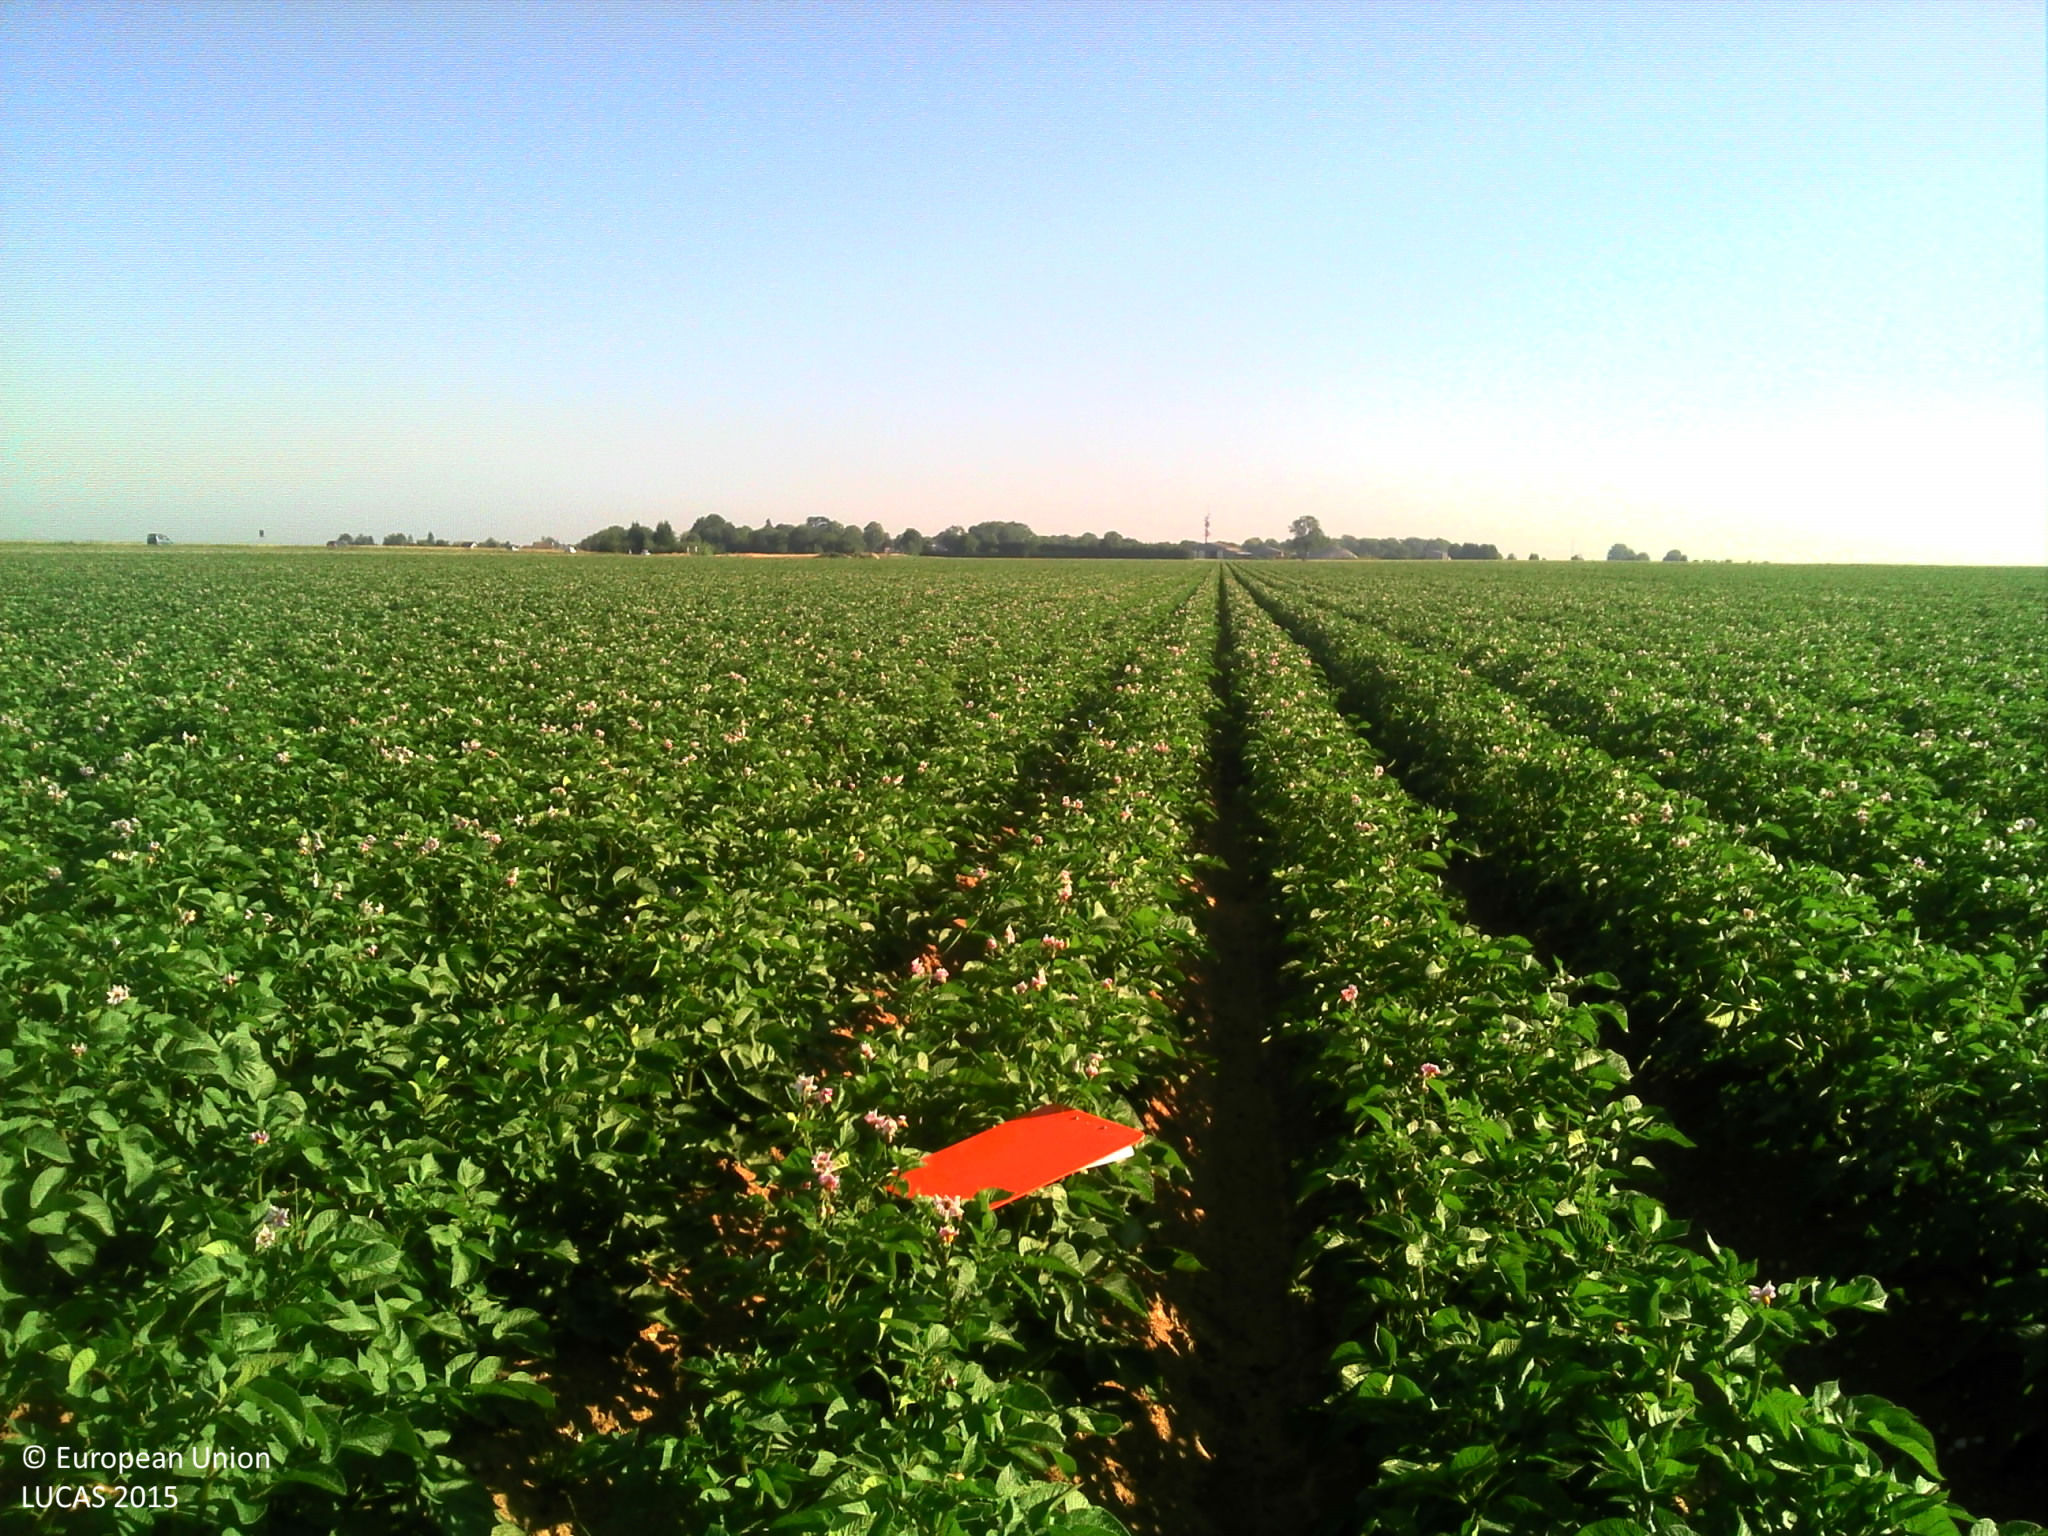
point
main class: Cropland
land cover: Potatoes
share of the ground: > 75 %
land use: Agriculture (excluding fallow land and kitchen gardens)
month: June
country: FR
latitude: 49.8313
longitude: 2.2706
